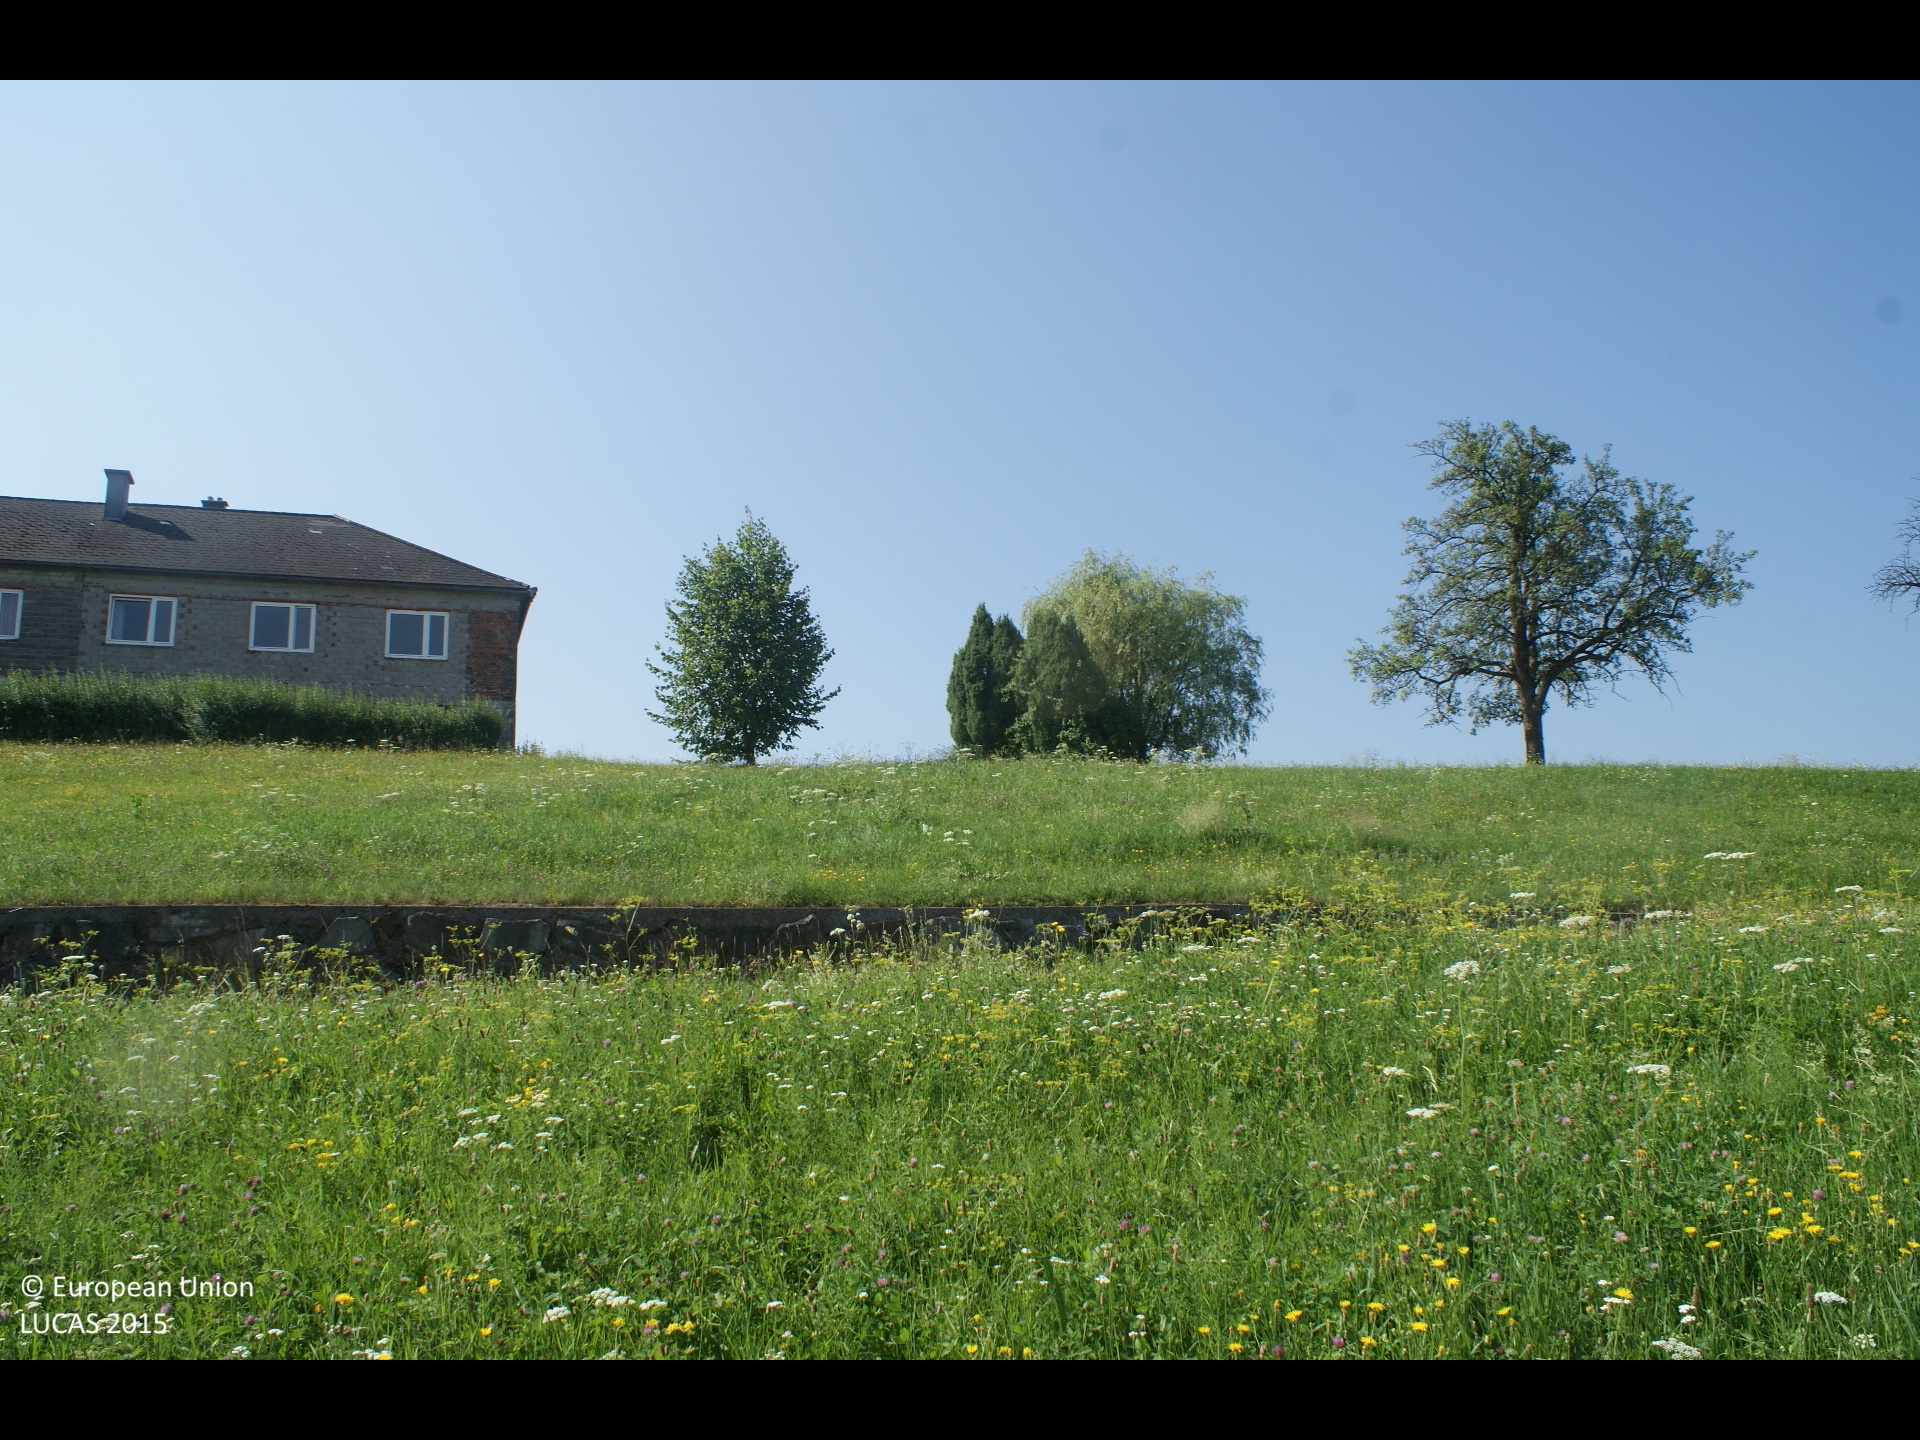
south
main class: Cropland
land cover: Common wheat
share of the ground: > 75 %
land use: Agriculture (excluding fallow land and kitchen gardens)
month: July
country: AT
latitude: 48.0570
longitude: 14.9787
